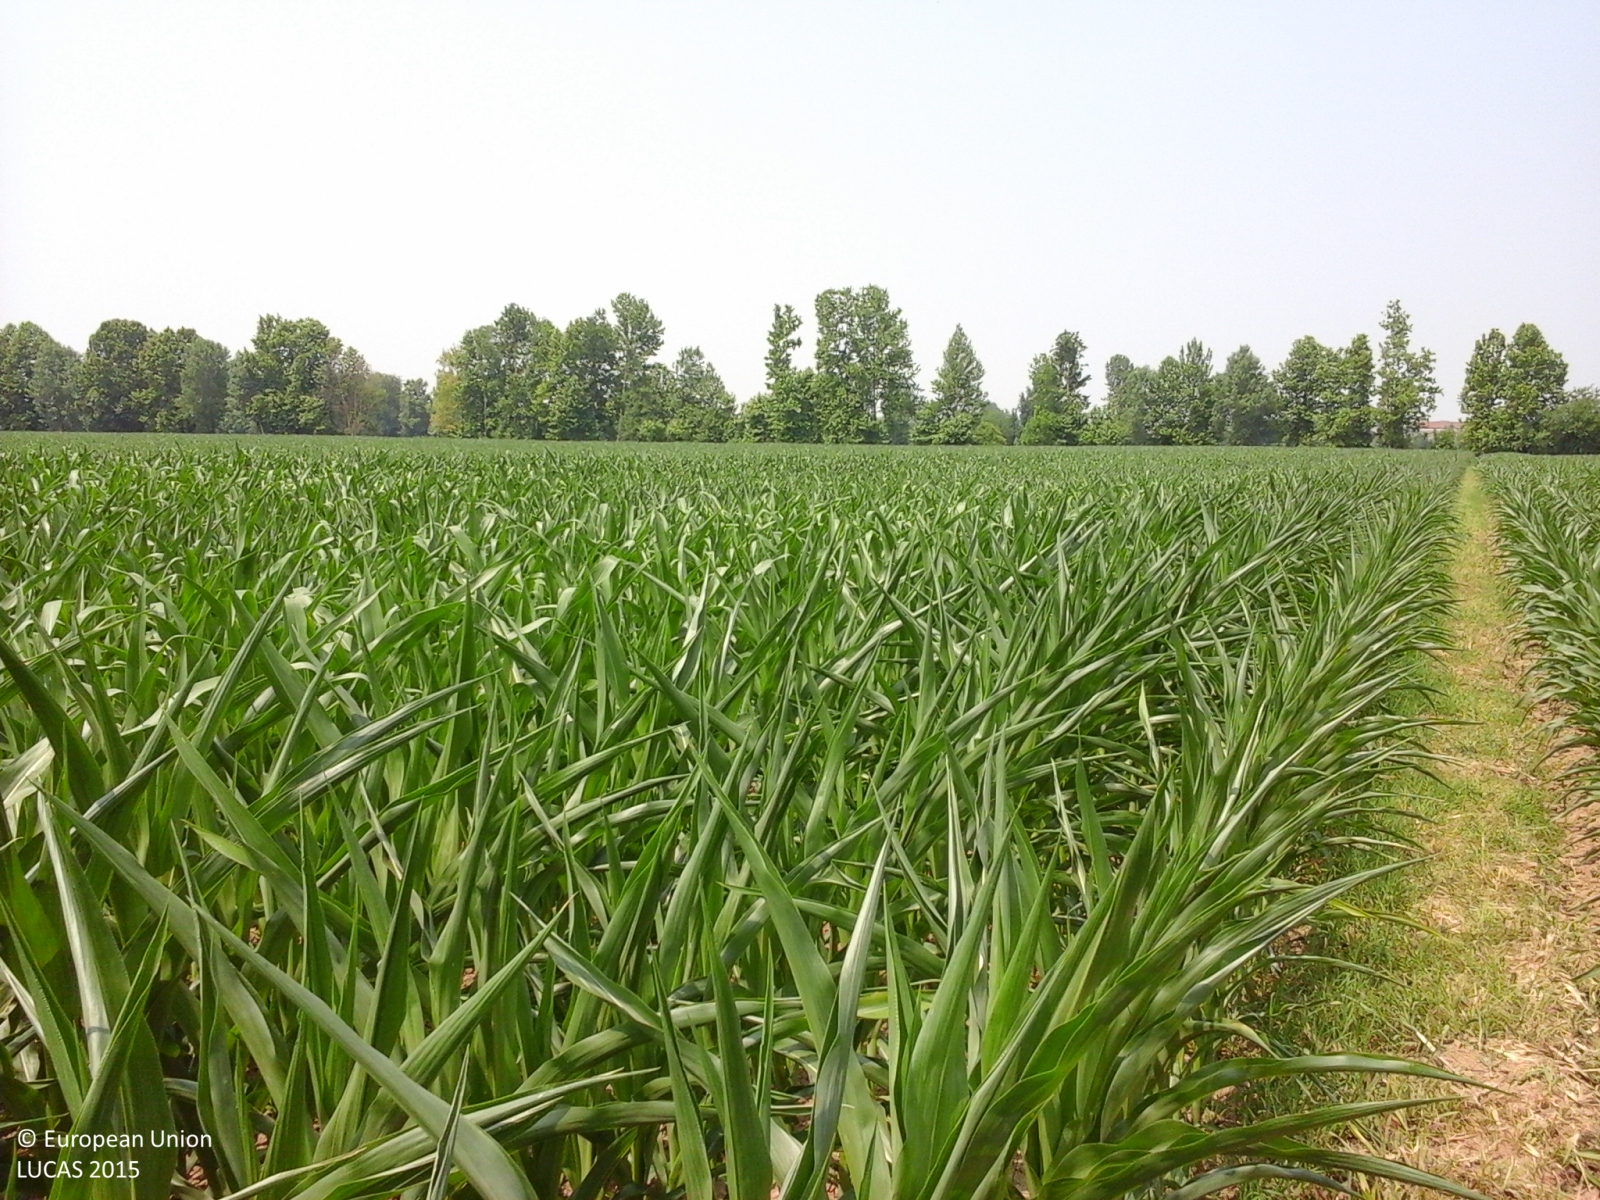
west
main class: Cropland
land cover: Maize
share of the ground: > 75 %
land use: Agriculture (excluding fallow land and kitchen gardens)
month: June
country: IT
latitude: 45.4682
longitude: 10.1915
